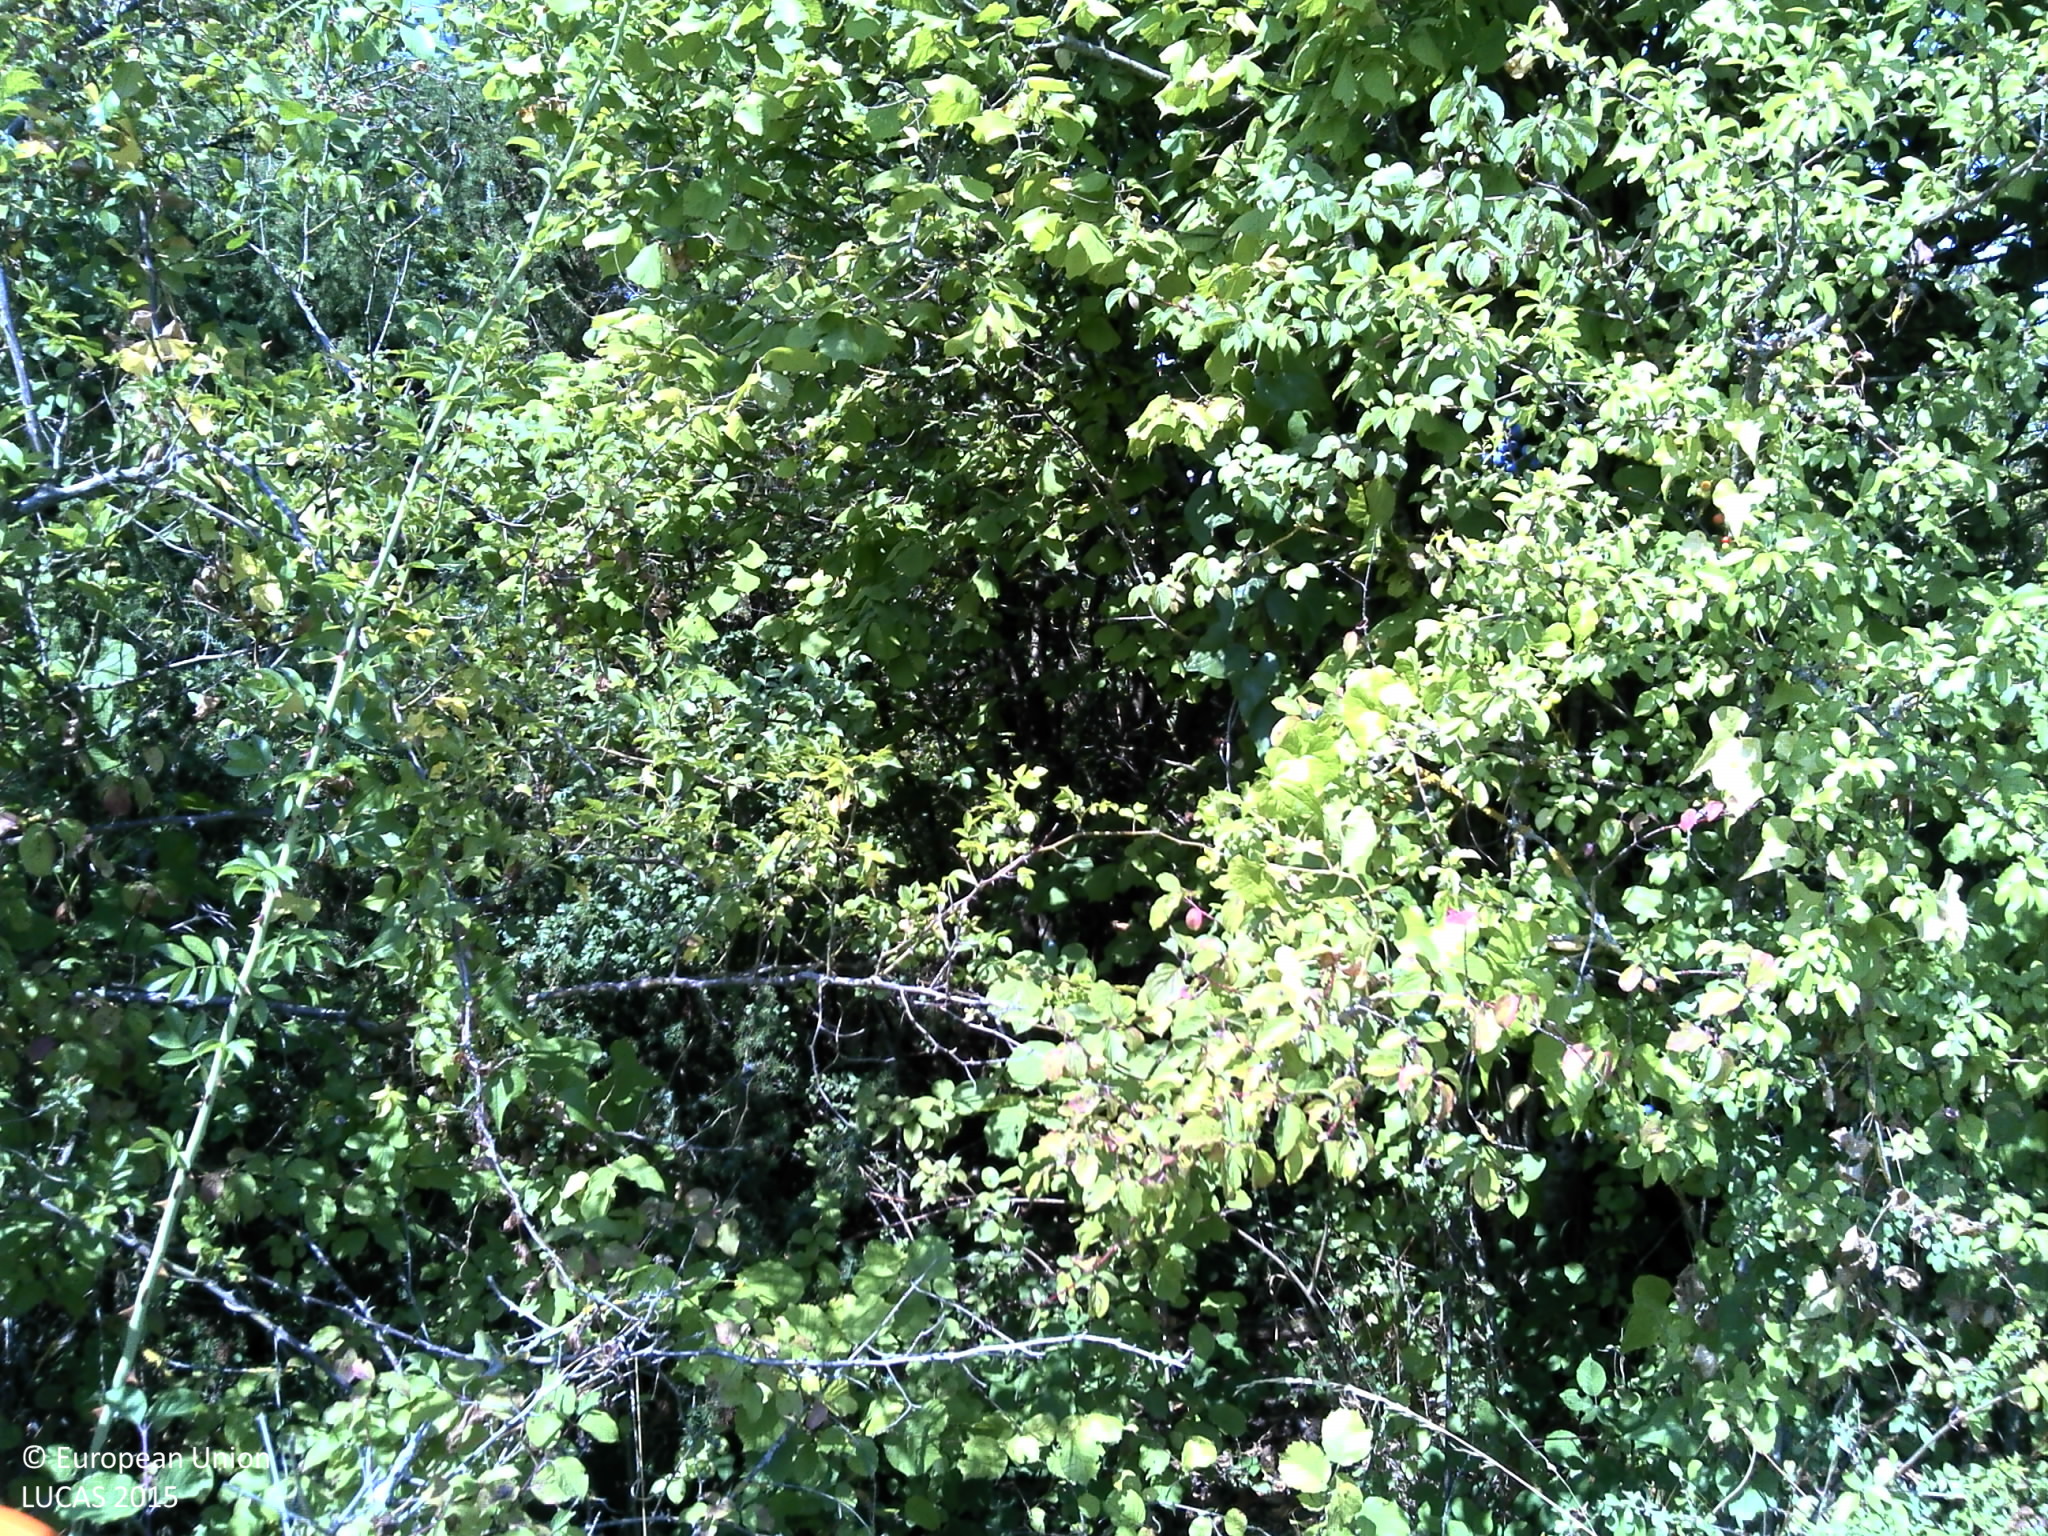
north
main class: Woodland
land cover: Spruce dominated mixed woodland
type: thermophilous deciduous forest
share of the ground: > 75 %
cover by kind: broadleaved forest trees 50 %, coniferous forest trees 25 %, herbaceous plants 20 %, shrubs 5 %
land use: Semi-natural and natural areas not in use
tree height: > 5 m
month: August
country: FR
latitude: 48.9096
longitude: 4.7444
